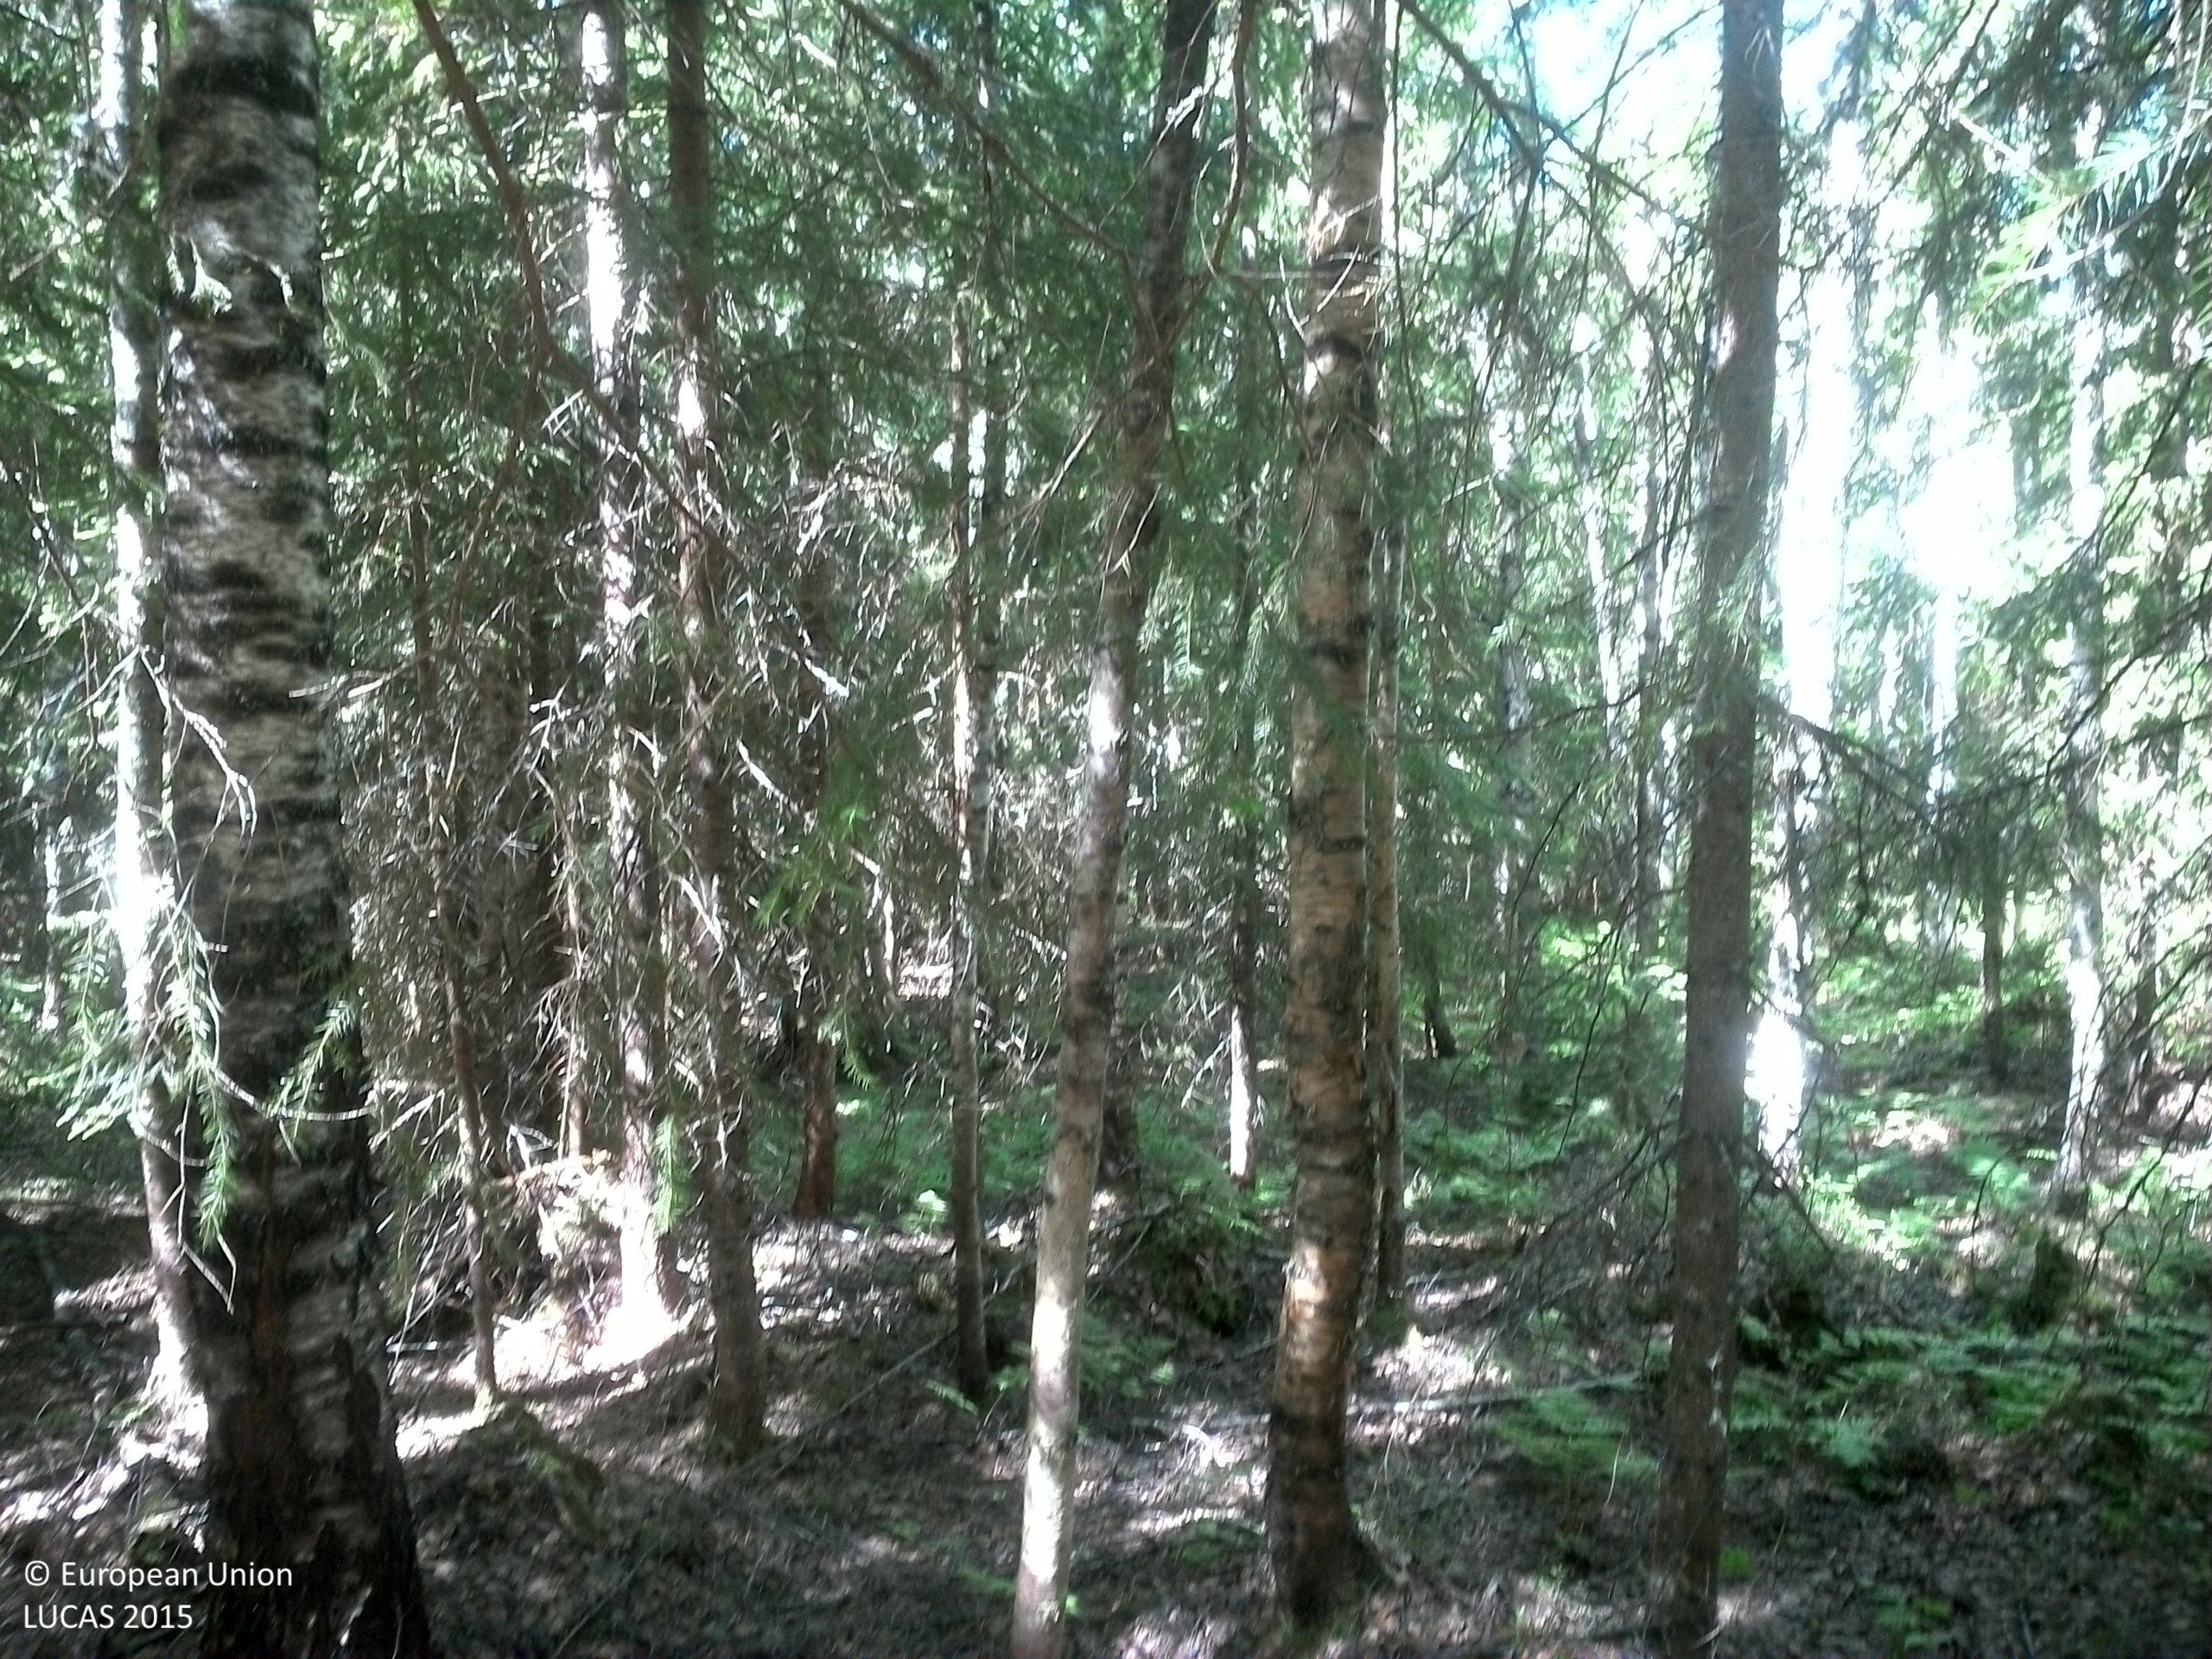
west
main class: Woodland
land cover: Spruce dominated mixed woodland
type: boreal forest
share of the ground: > 75 %
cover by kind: coniferous forest trees 65 %, broadleaved forest trees 25 %, herbaceous plants 10 %
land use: Forestry
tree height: > 5 m
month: July
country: SE
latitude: 62.7808
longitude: 17.6411
